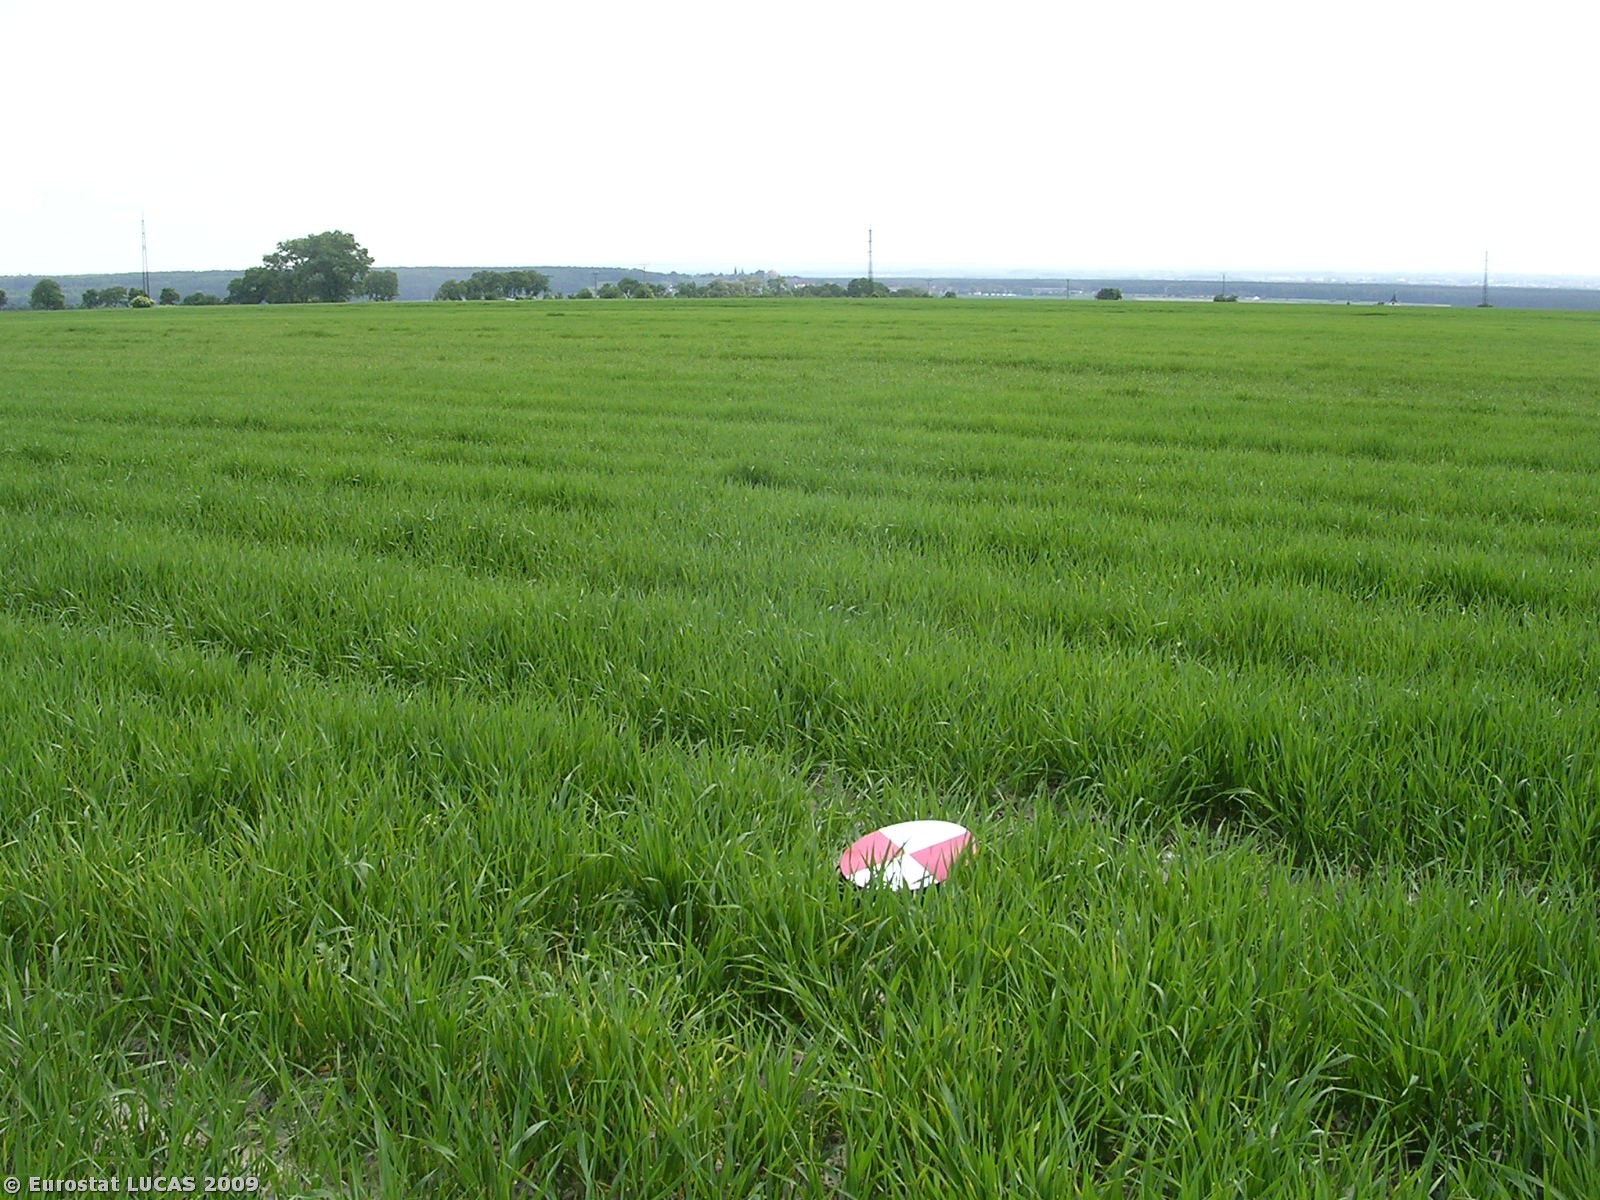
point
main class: Cropland
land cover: Barley
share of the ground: > 75 %
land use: Agriculture (excluding fallow land and kitchen gardens)
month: May
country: CZ
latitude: 50.2674
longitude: 14.7020
